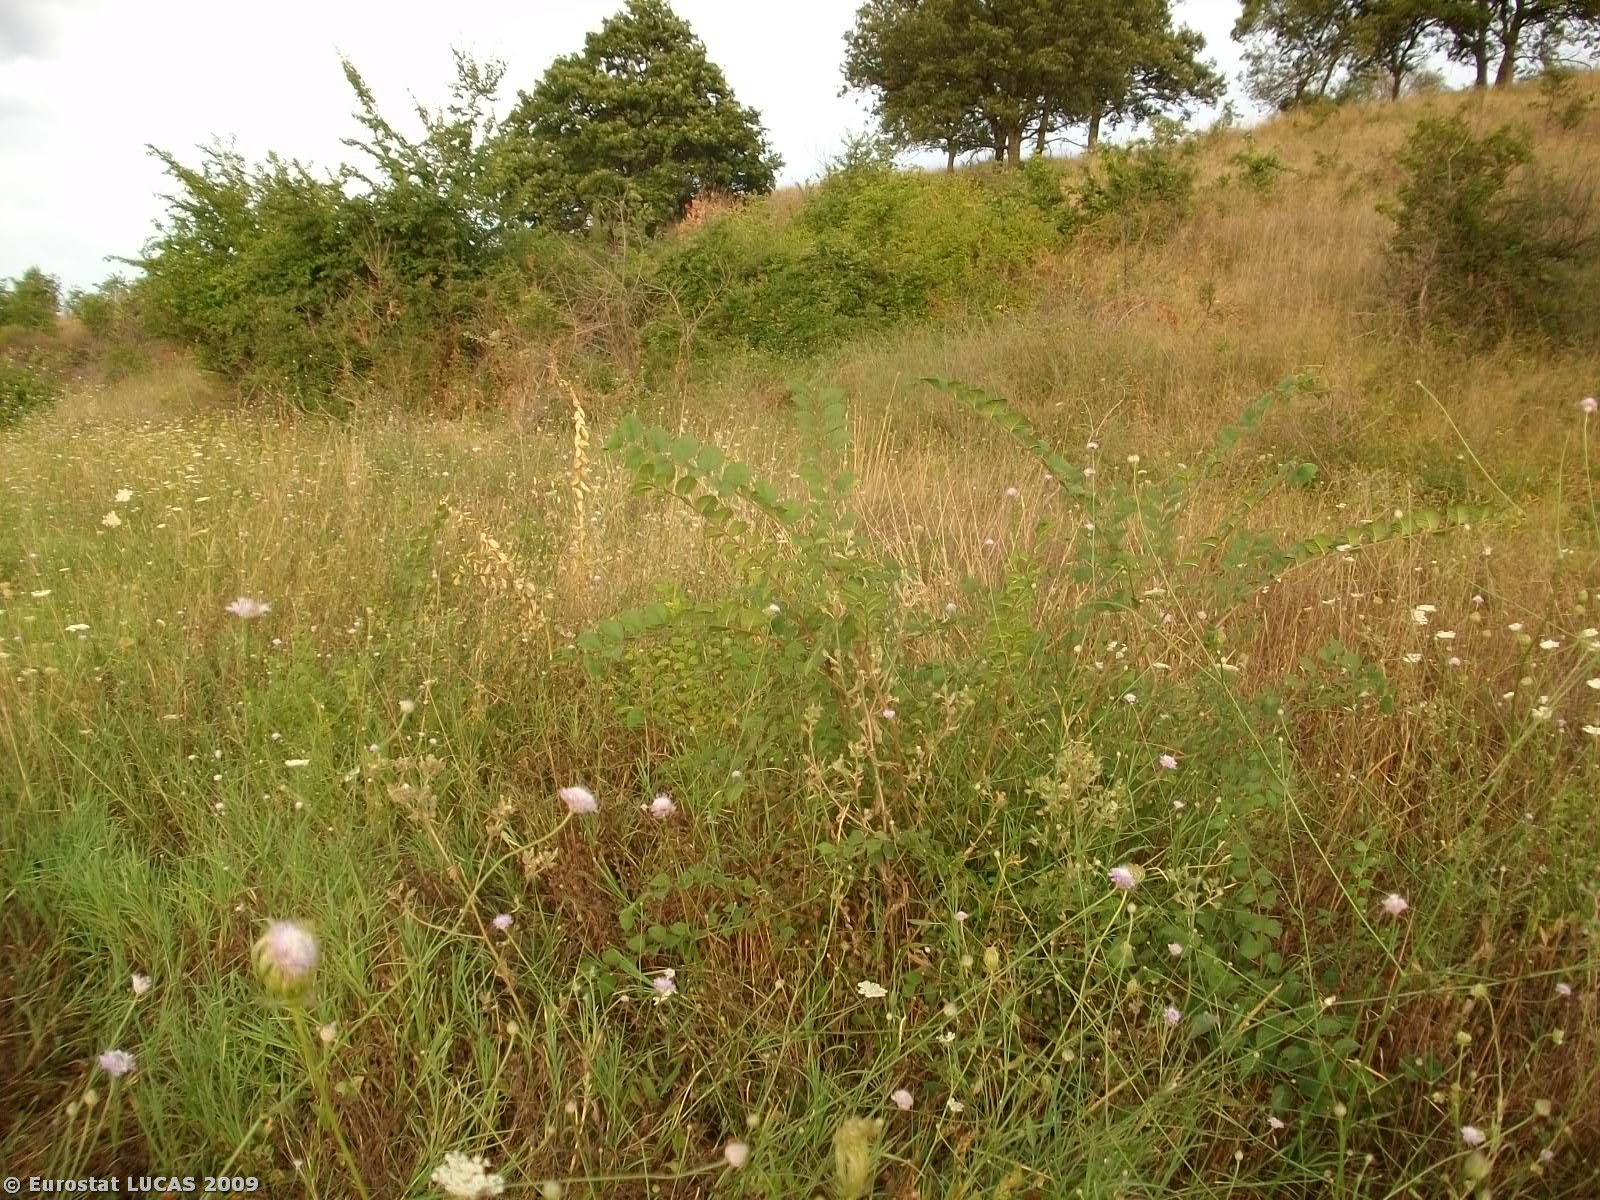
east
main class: Grassland
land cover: Grassland without tree/shrub cover
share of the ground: > 75 %
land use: Unused
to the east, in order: Grassland without tree/shrub cover; Broadleaved woodland; Grassland without tree/shrub cover; Lucerne; Grass margins; Spontaneously vegetated surfaces
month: August
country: GR
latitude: 41.3631
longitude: 26.3920
